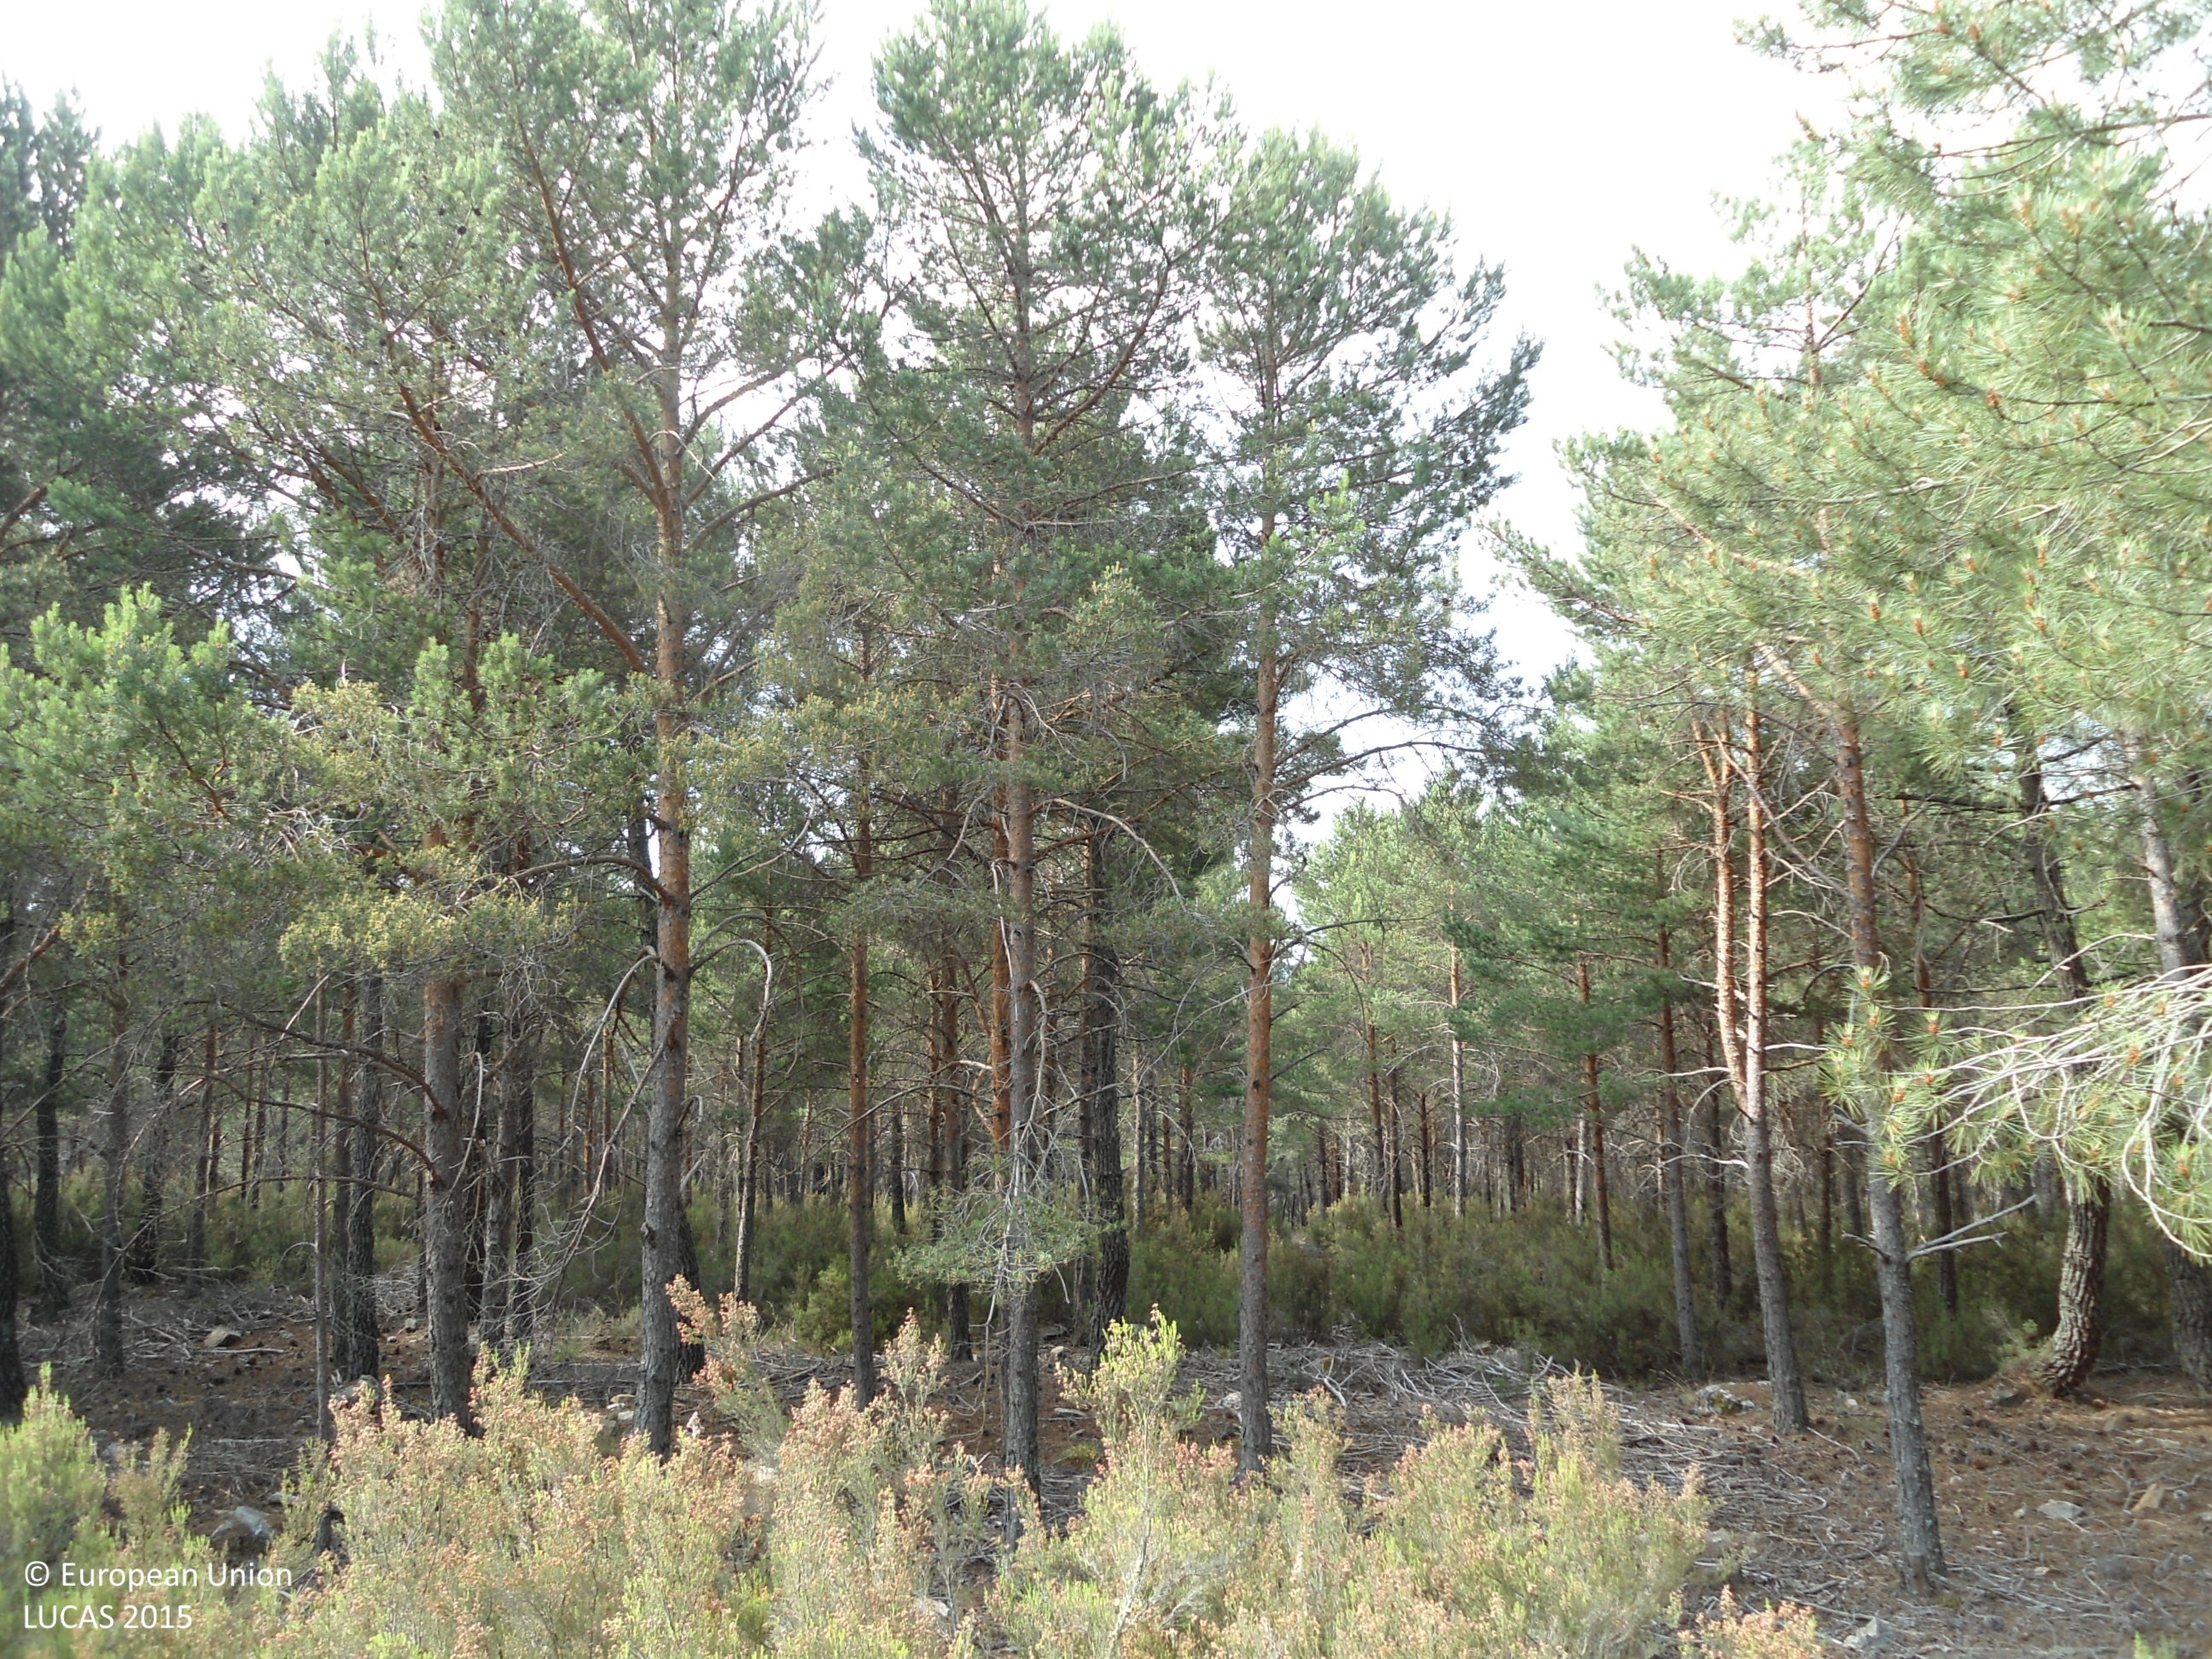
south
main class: Shrubland
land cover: Shrubland with sparse tree cover
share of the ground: > 75 %
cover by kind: shrubs 80 %, consolidated bare surface 15 %, coniferous forest trees 5 %
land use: Forestry
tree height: < 5 m
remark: Fire break
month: June
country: ES
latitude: 41.9102
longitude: -6.1963
